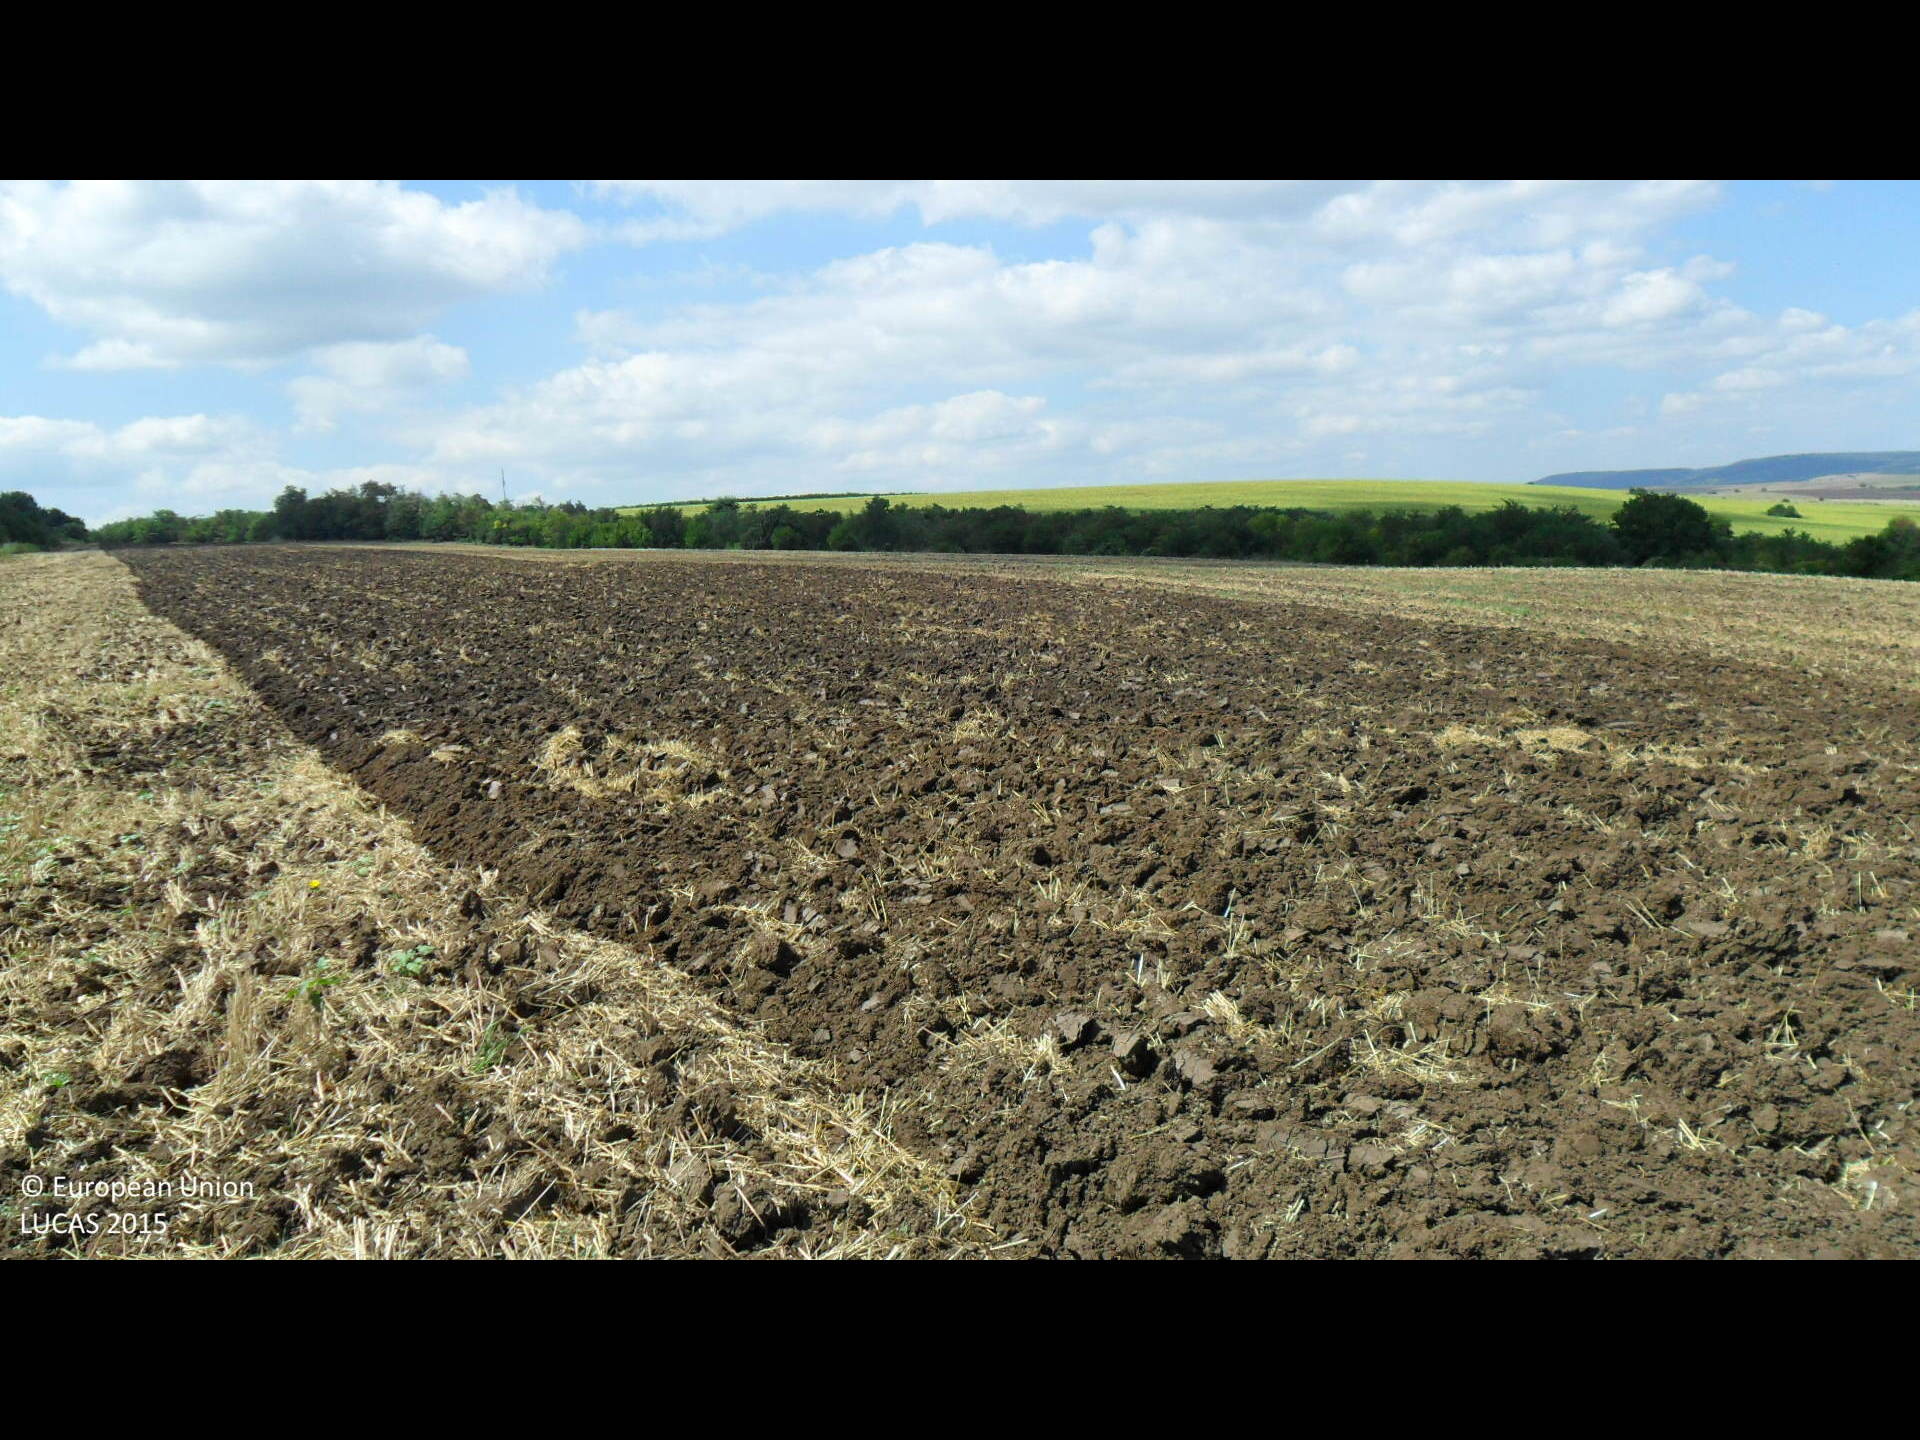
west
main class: Cropland
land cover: Common wheat
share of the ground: 25 - 50 %
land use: Agriculture (excluding fallow land and kitchen gardens)
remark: Harvested field
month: August
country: BG
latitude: 43.4435
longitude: 26.3737
